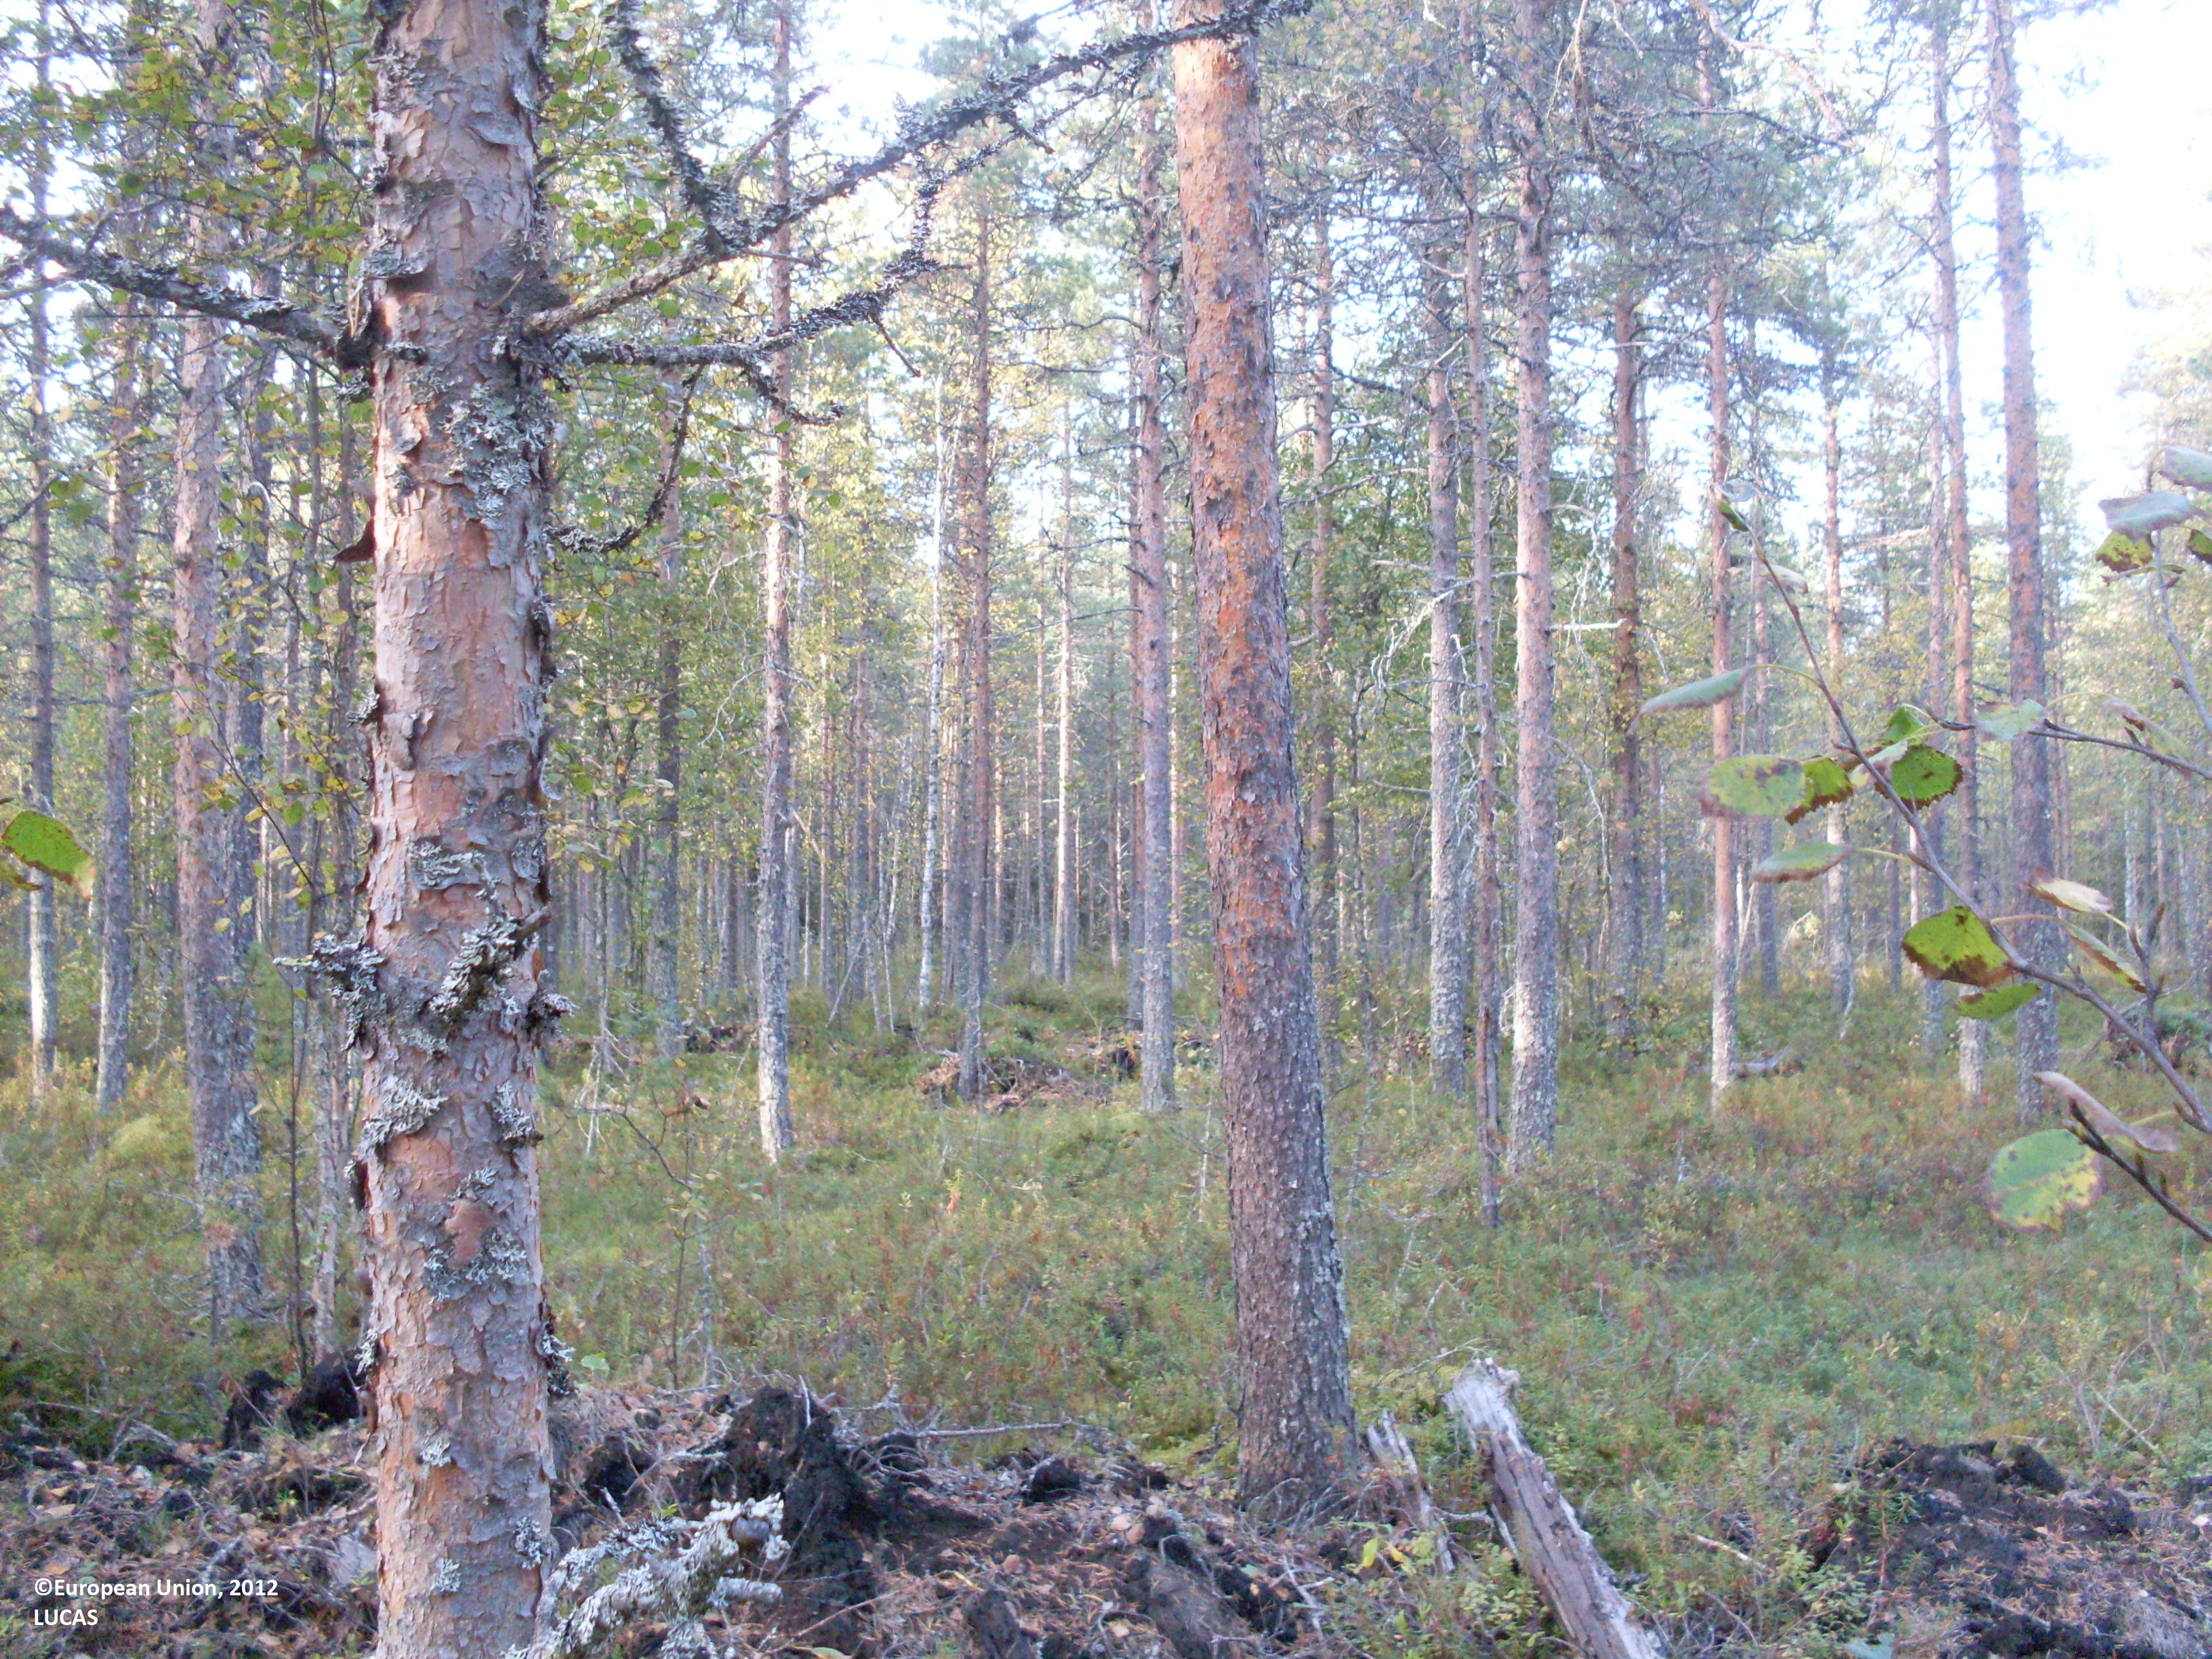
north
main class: Woodland
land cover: Pine dominated coniferous woodland
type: boreal forest
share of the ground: 50 - 75 %
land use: Forestry
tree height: > 5 m
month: September
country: FI
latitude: 64.0790
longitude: 29.2578
